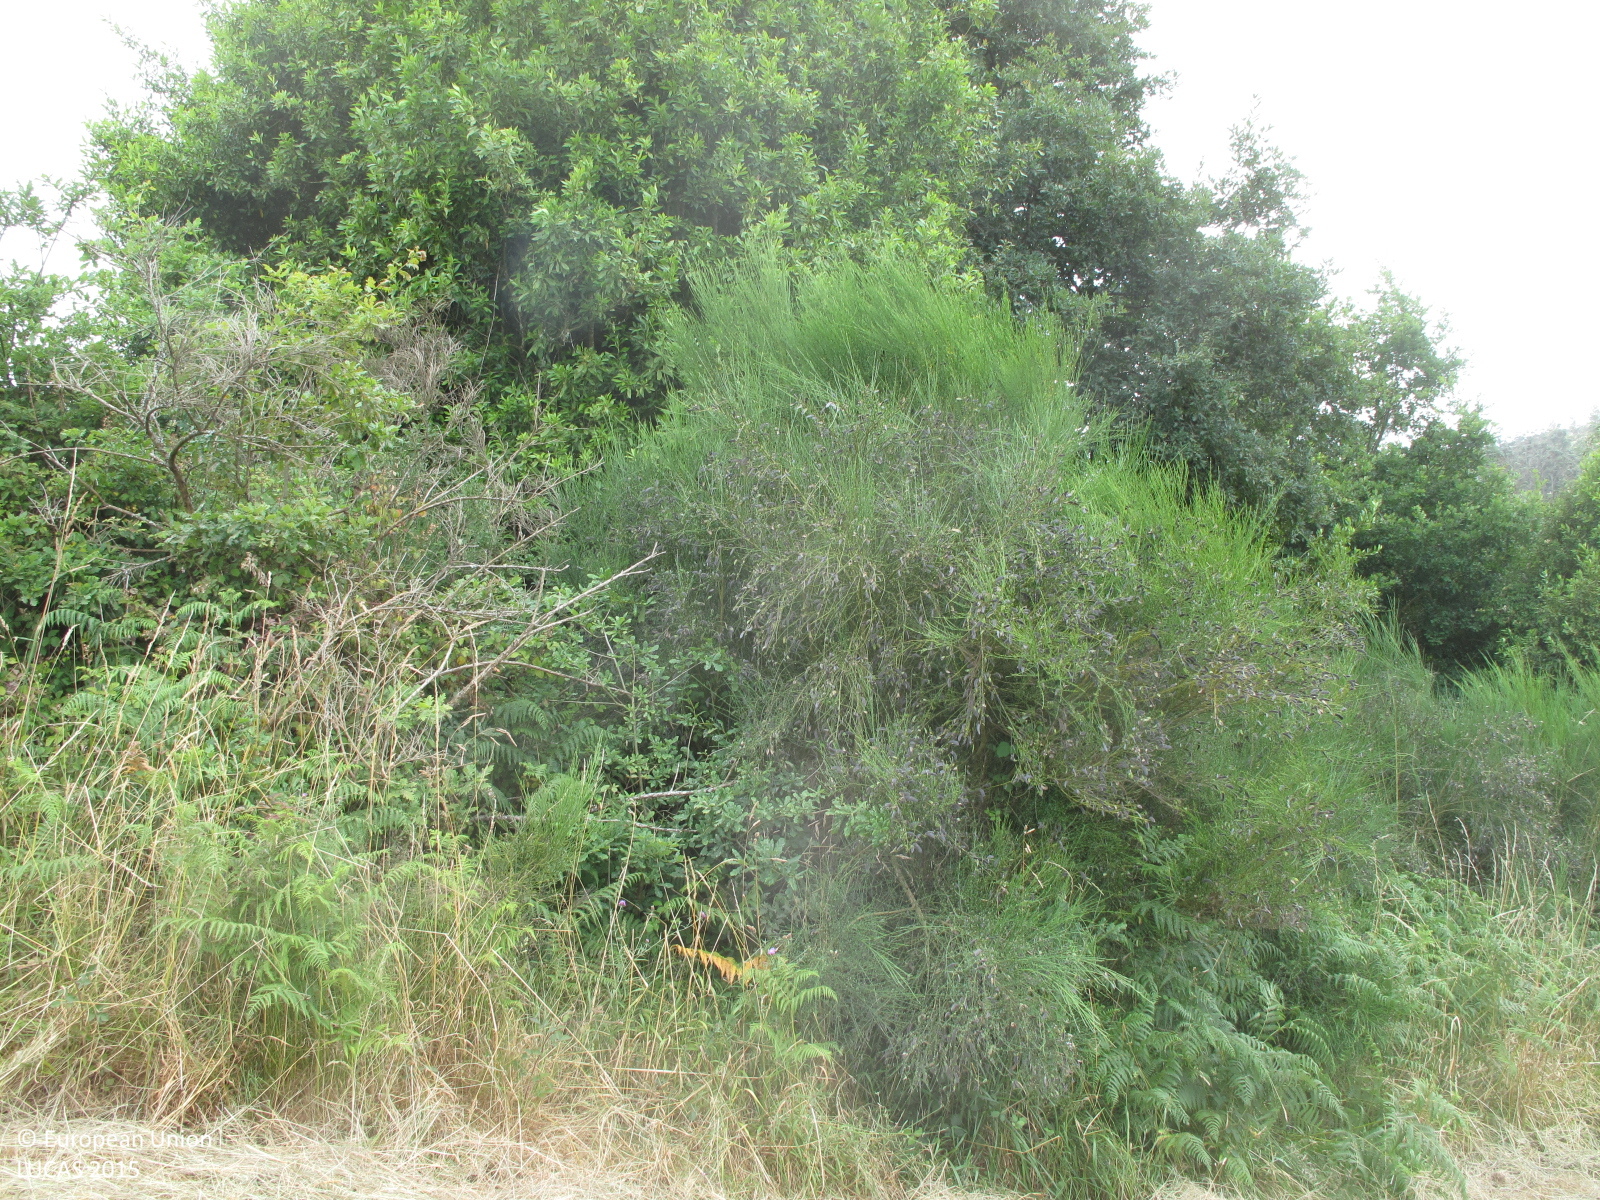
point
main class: Woodland
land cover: Broadleaved woodland
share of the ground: 50 - 75 %
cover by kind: broadleaved forest trees 70 %, shrubs 20 %, herbaceous plants 10 %
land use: Forestry
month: July
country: ES
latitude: 43.4608
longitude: -8.1066
